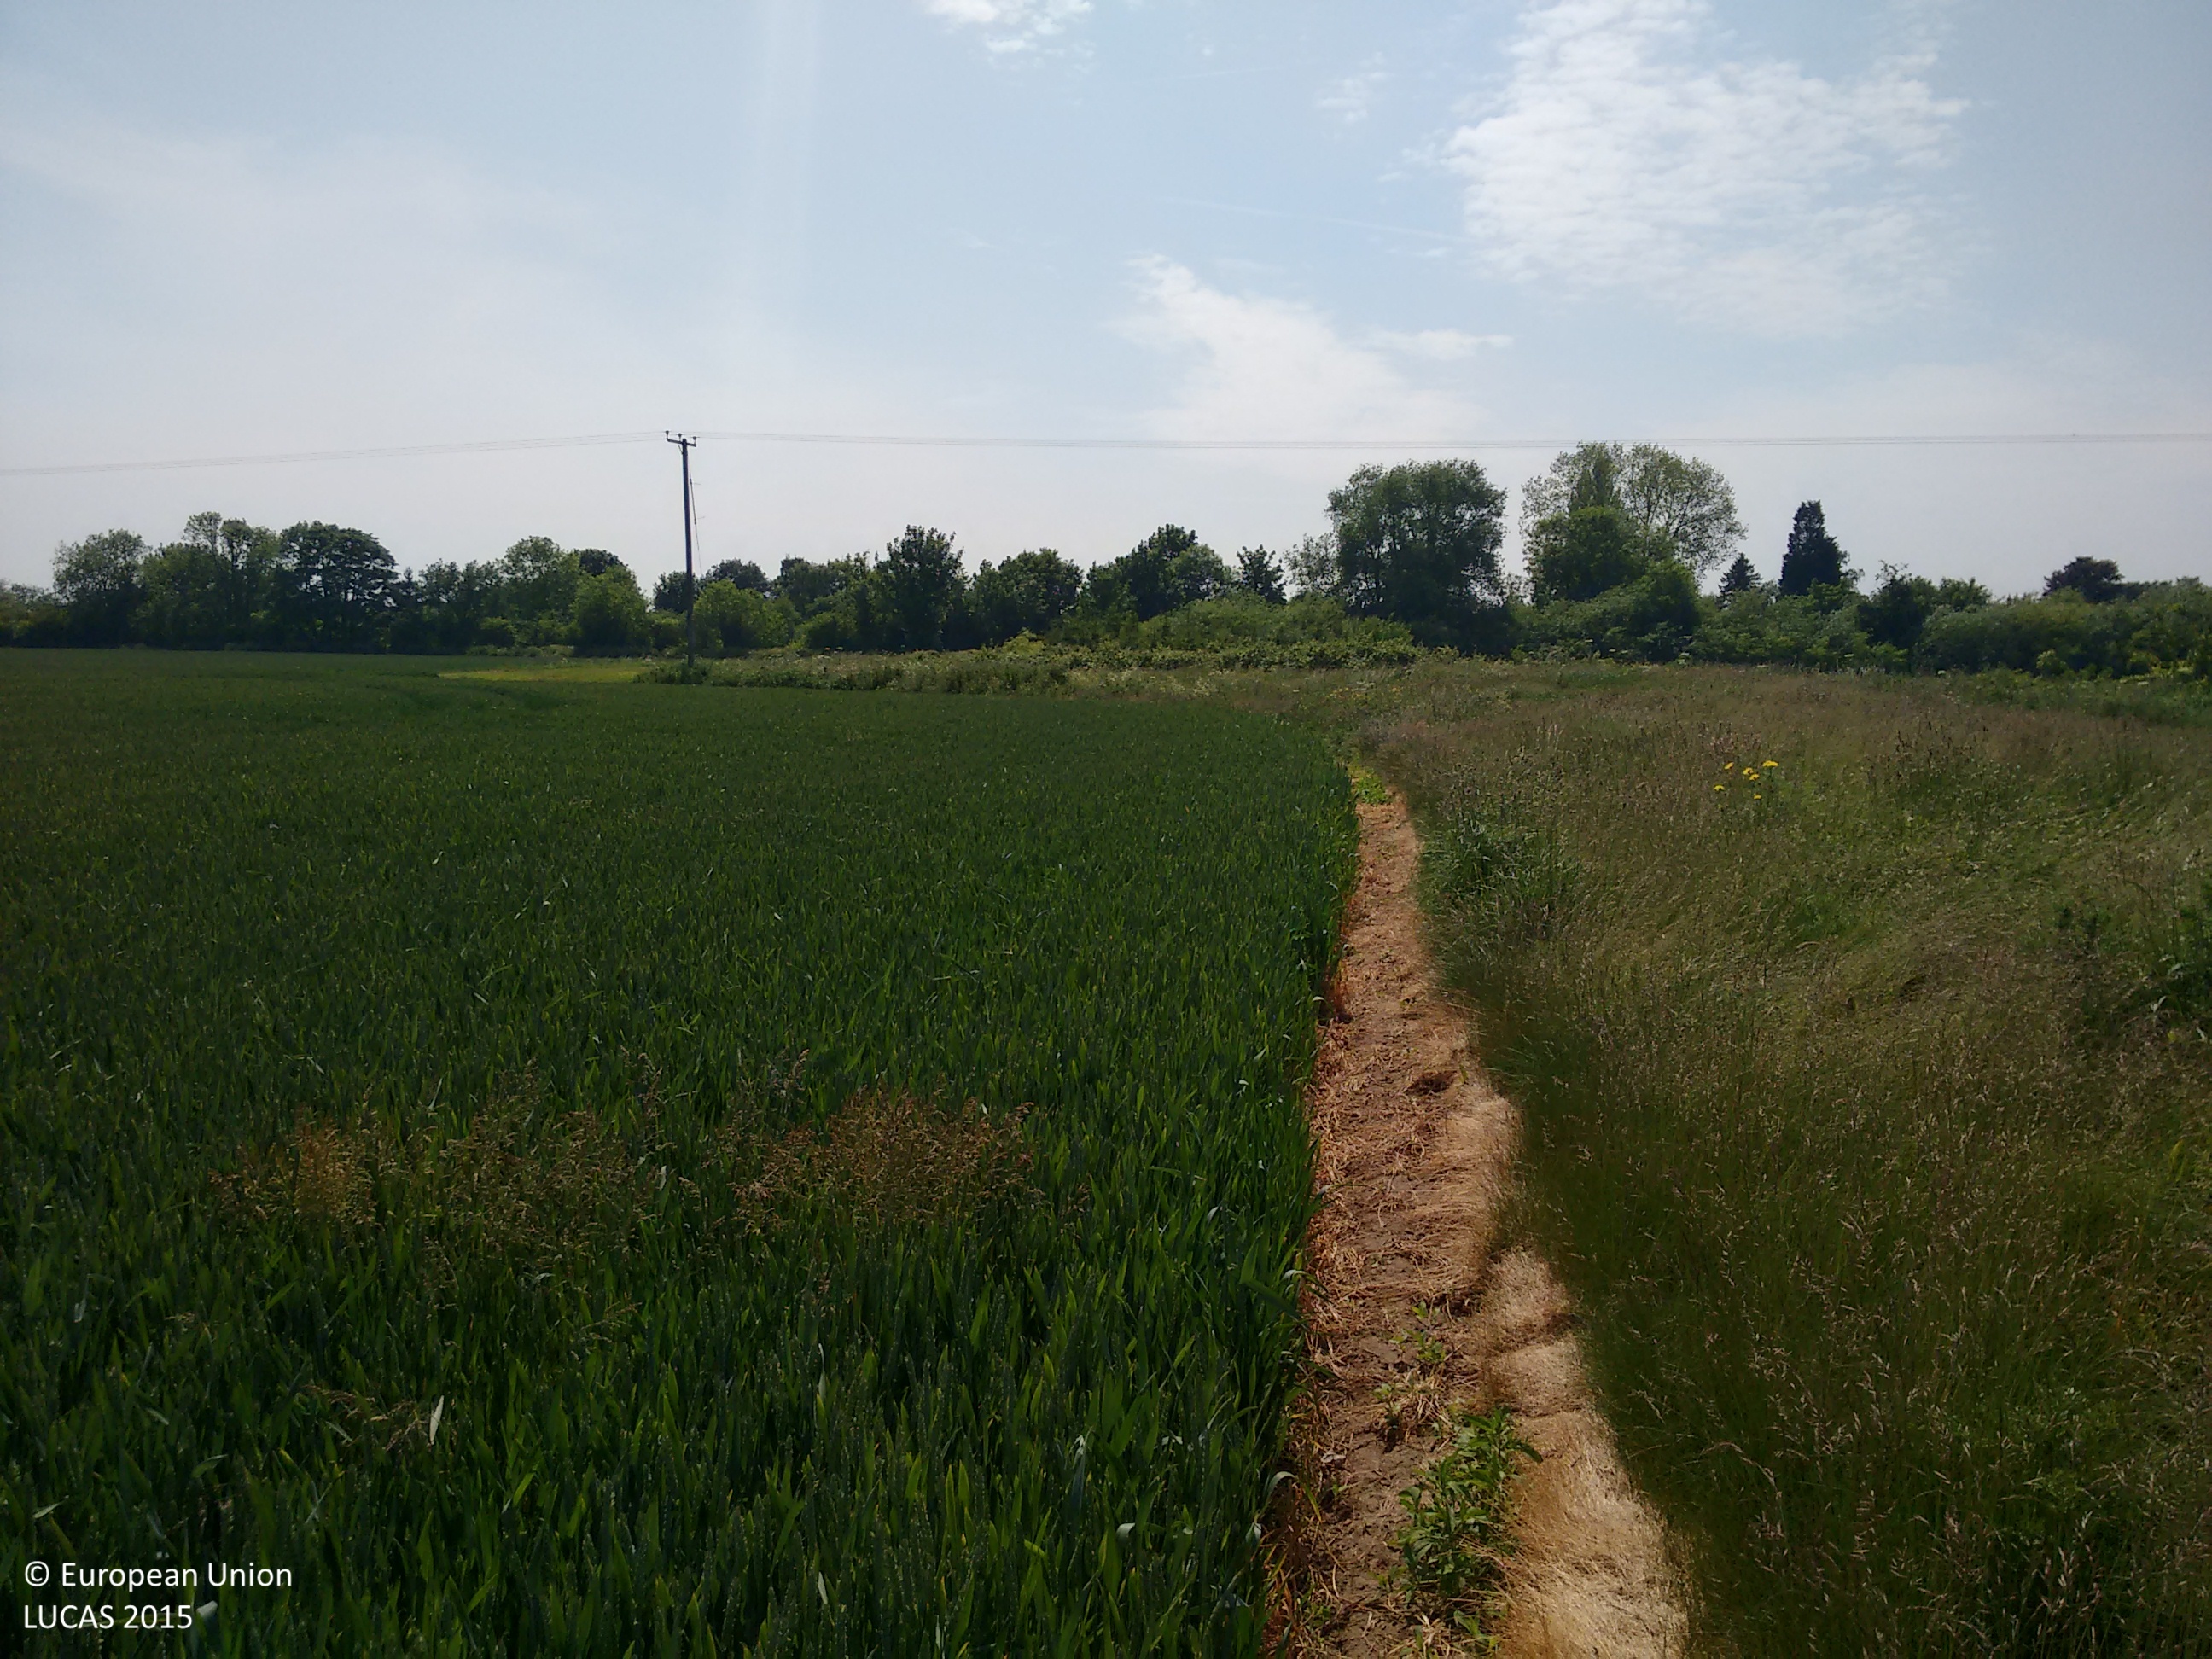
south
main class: Cropland
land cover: Common wheat
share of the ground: > 75 %
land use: Agriculture (excluding fallow land and kitchen gardens)
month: June
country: GB
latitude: 53.8320
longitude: -1.1213
